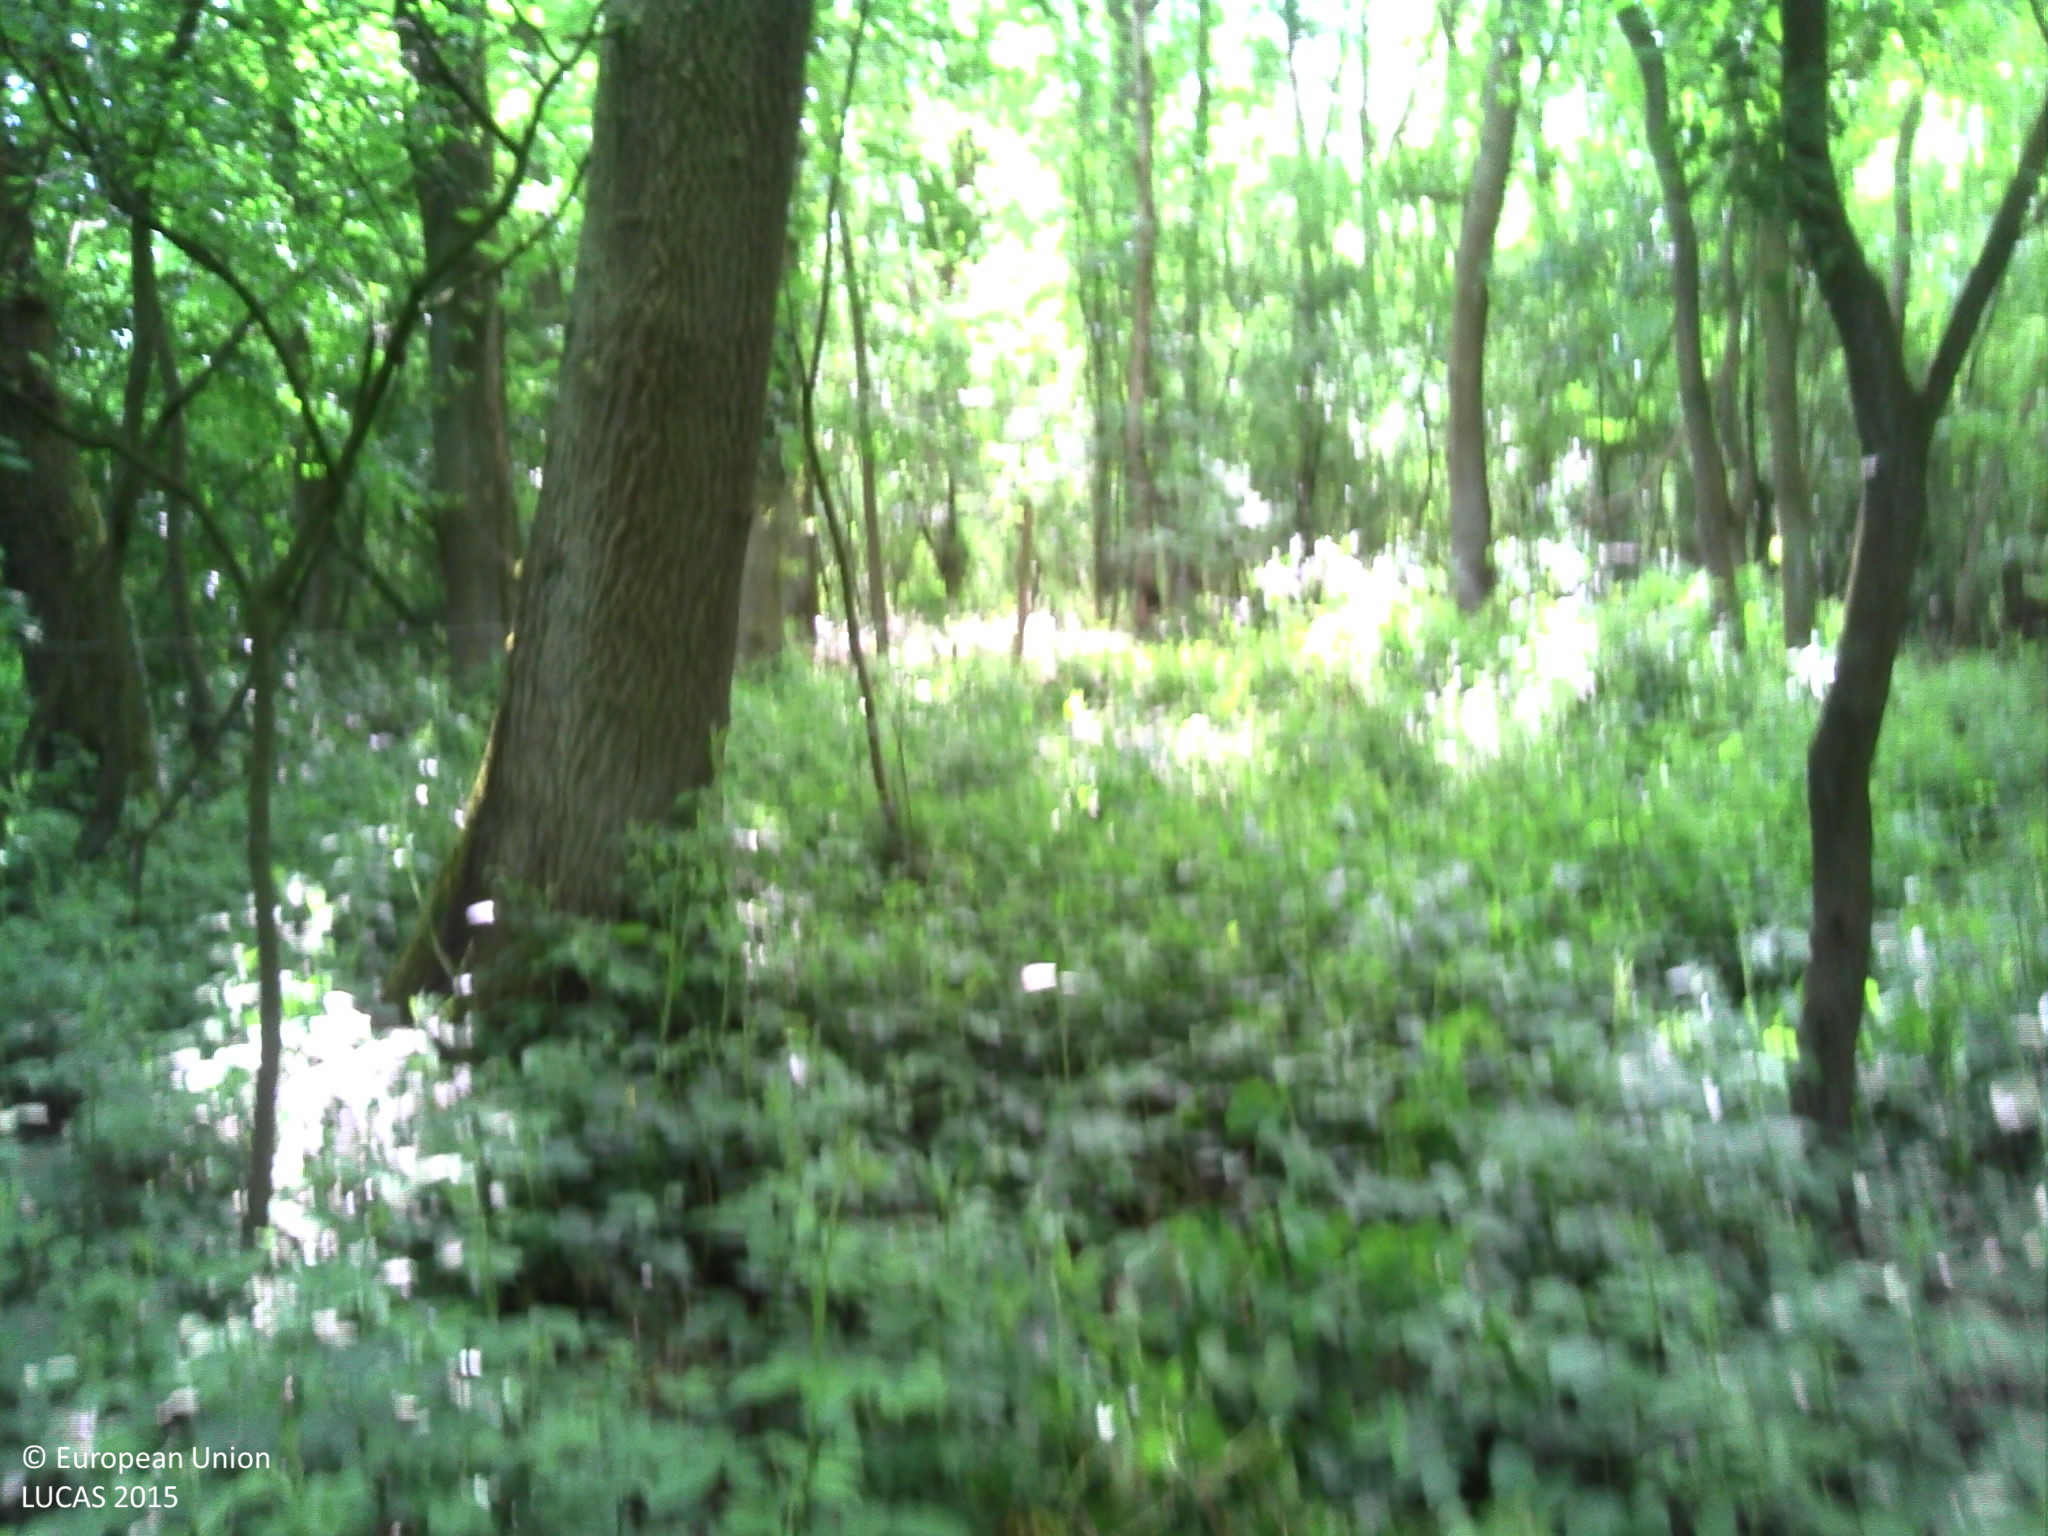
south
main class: Woodland
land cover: Broadleaved woodland
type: acidophilous oak and oak-birch forest
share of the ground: > 75 %
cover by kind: broadleaved forest trees 100 %
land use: Forestry
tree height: > 5 m
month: May
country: BE
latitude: 50.5564
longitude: 4.5050
